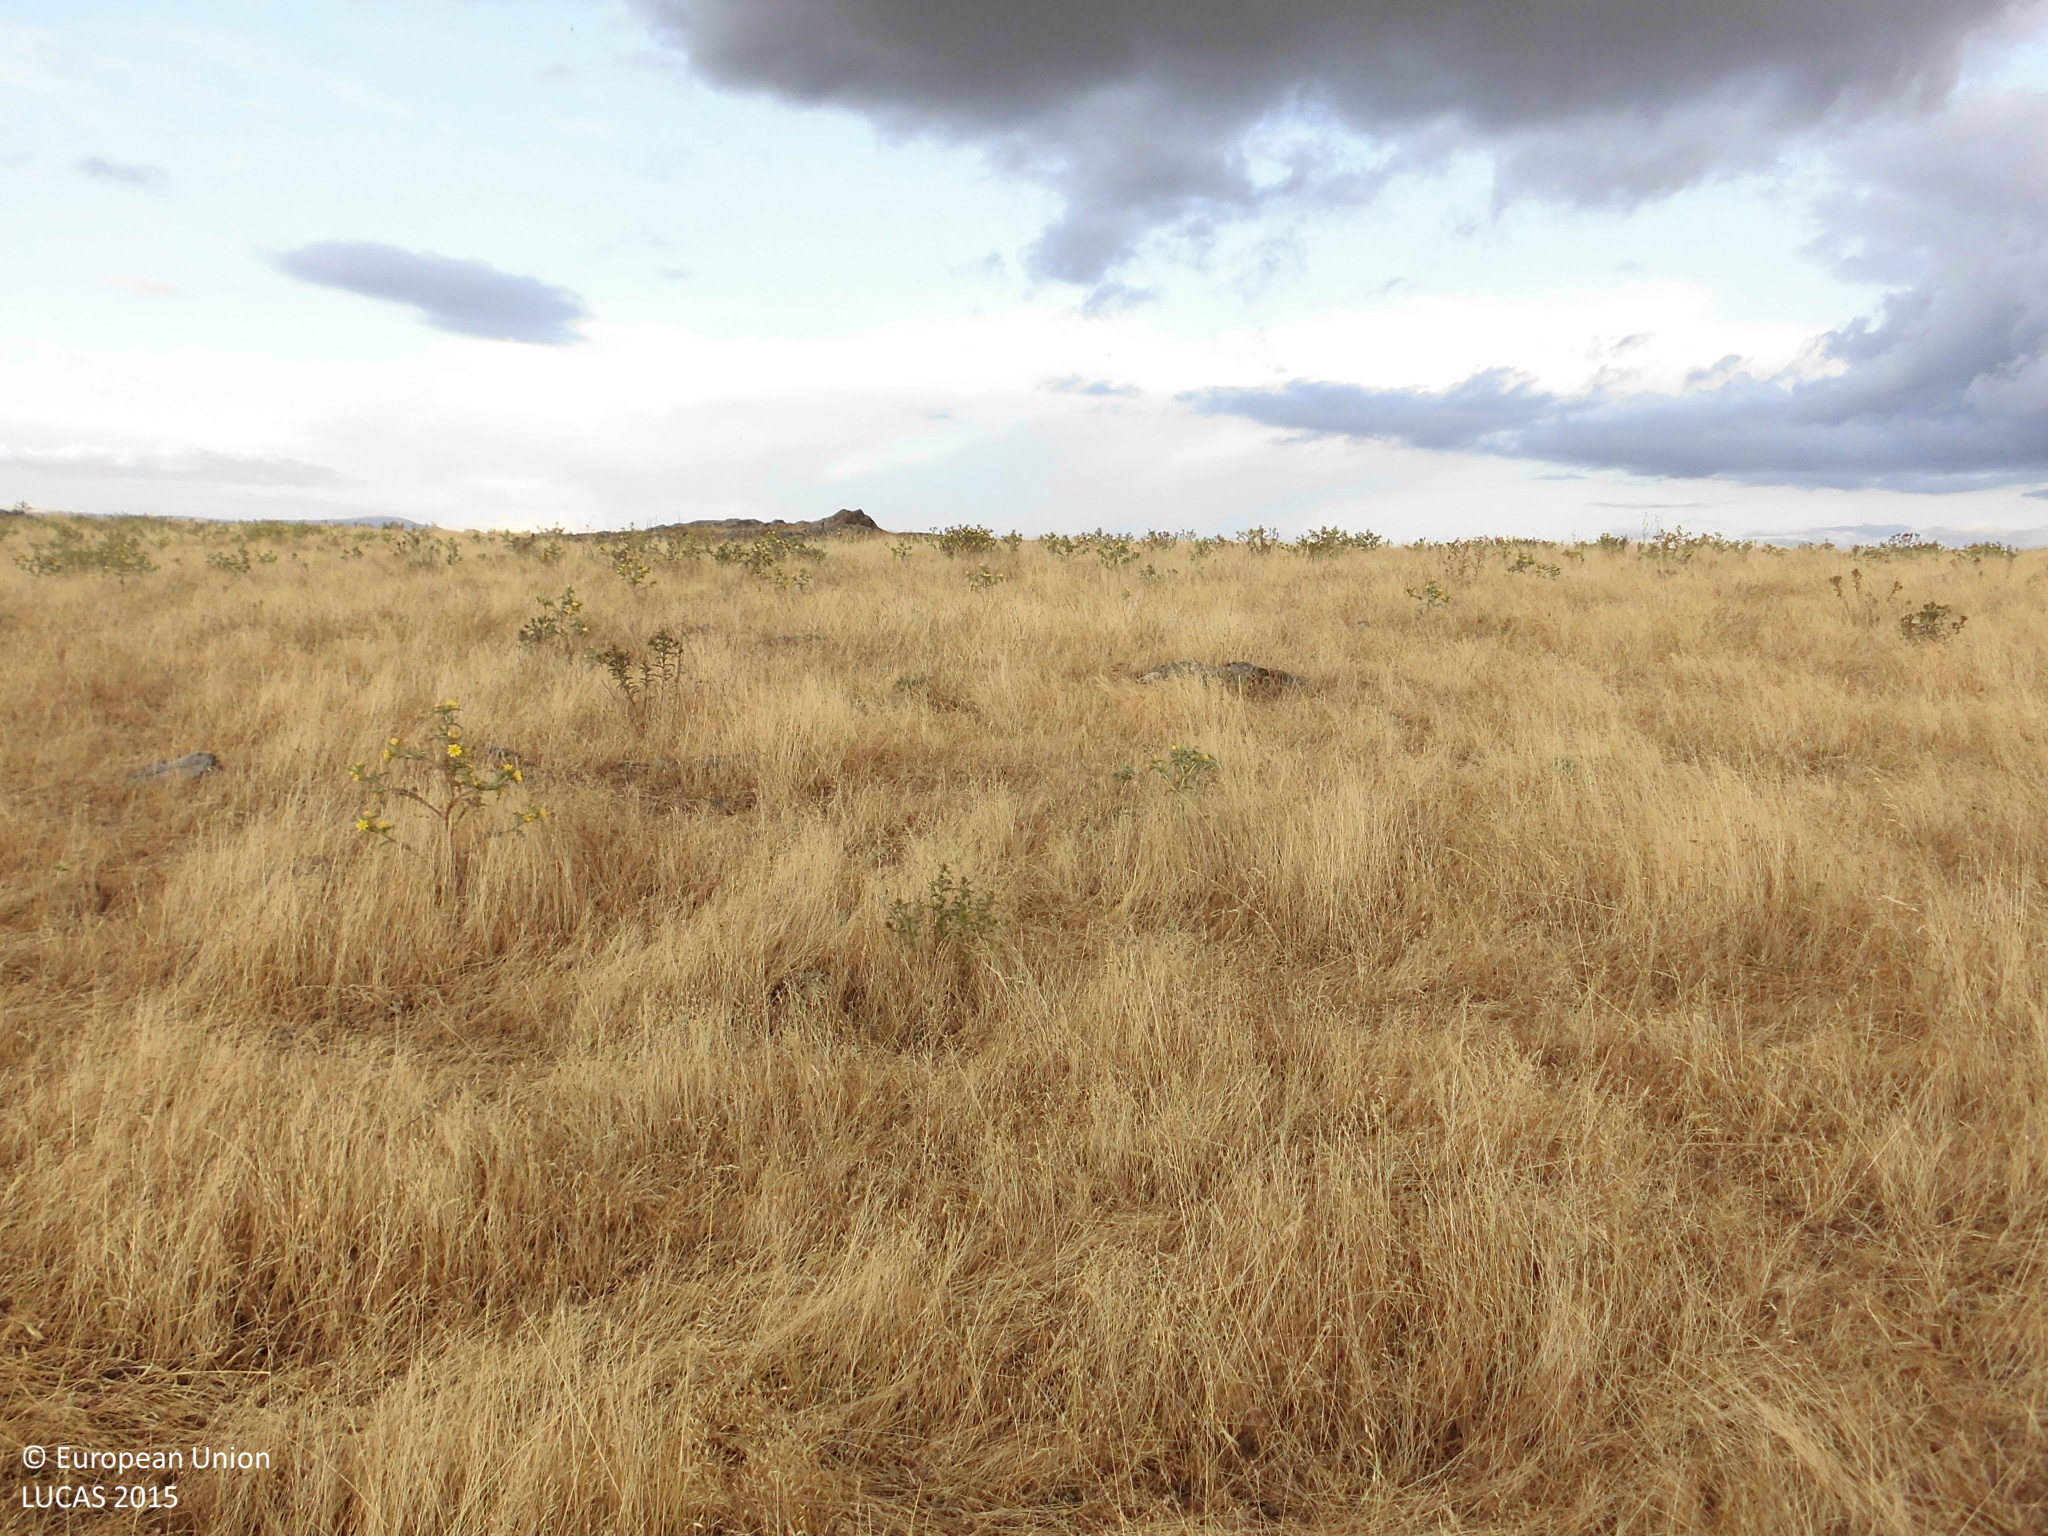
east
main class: Grassland
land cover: Grassland without tree/shrub cover
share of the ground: > 75 %
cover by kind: herbaceous plants 100 %
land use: Agriculture (excluding fallow land and kitchen gardens)
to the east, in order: Grassland without tree/shrub cover
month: June
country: ES
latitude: 39.3800
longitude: -5.9272
